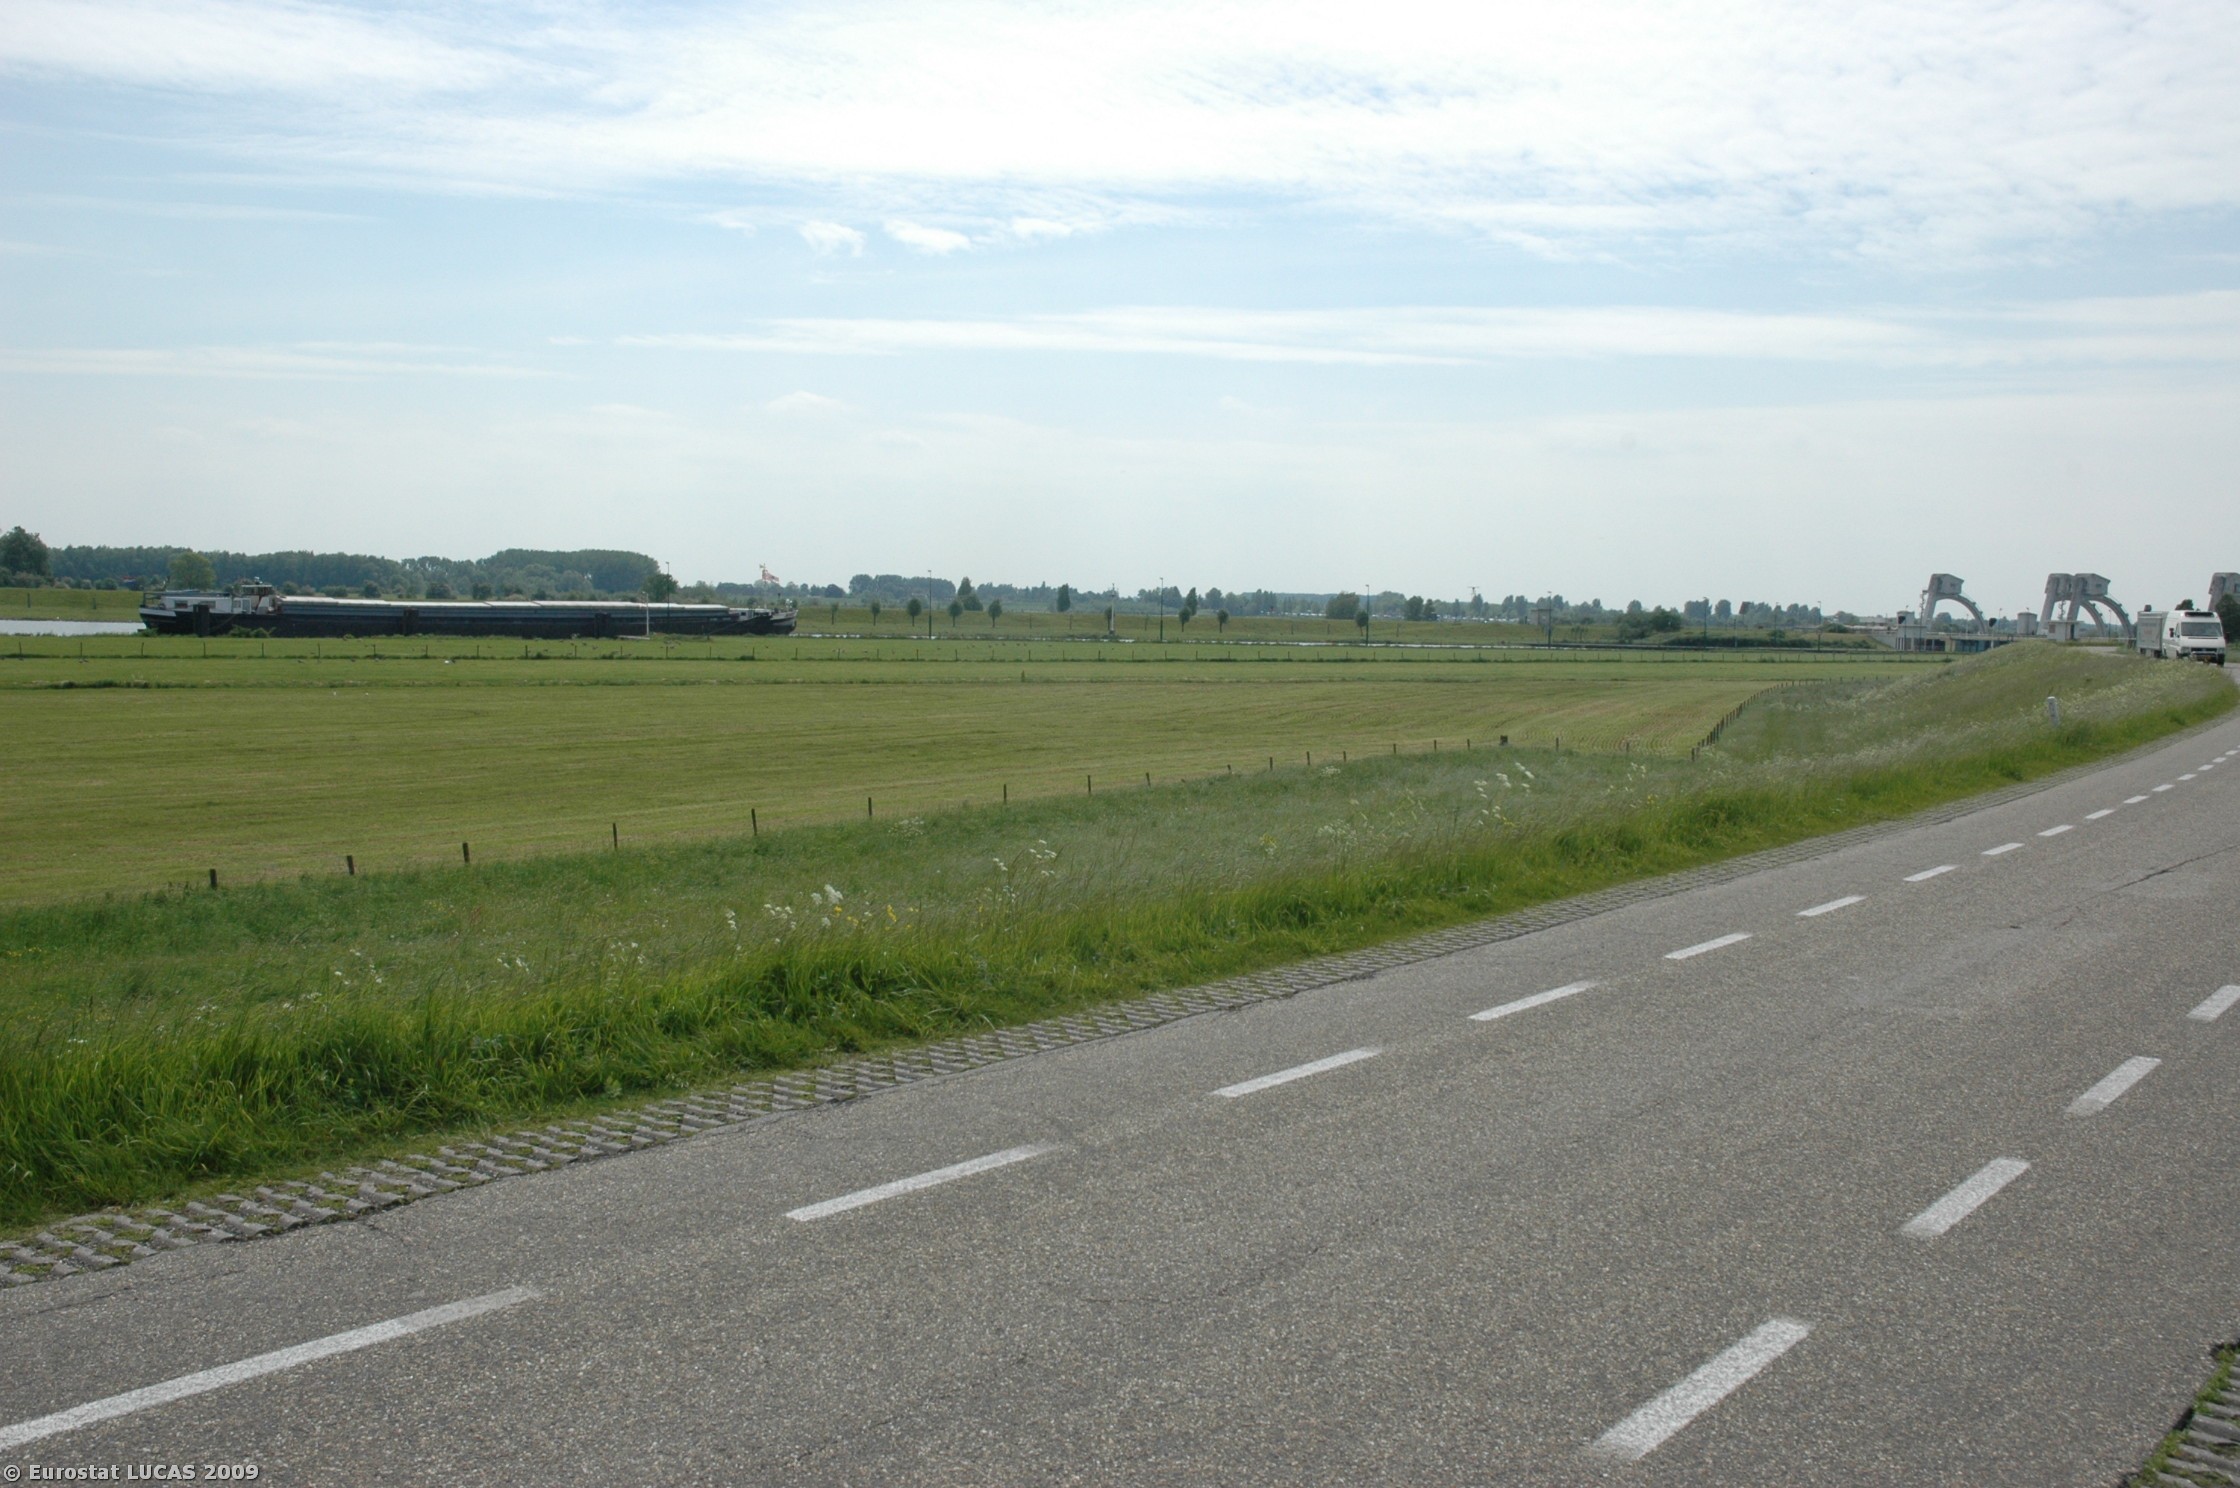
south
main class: Grassland
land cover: Grassland without tree/shrub cover
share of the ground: > 75 %
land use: Agriculture (excluding fallow land and kitchen gardens)
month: May
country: NL
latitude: 51.9828
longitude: 5.4116
